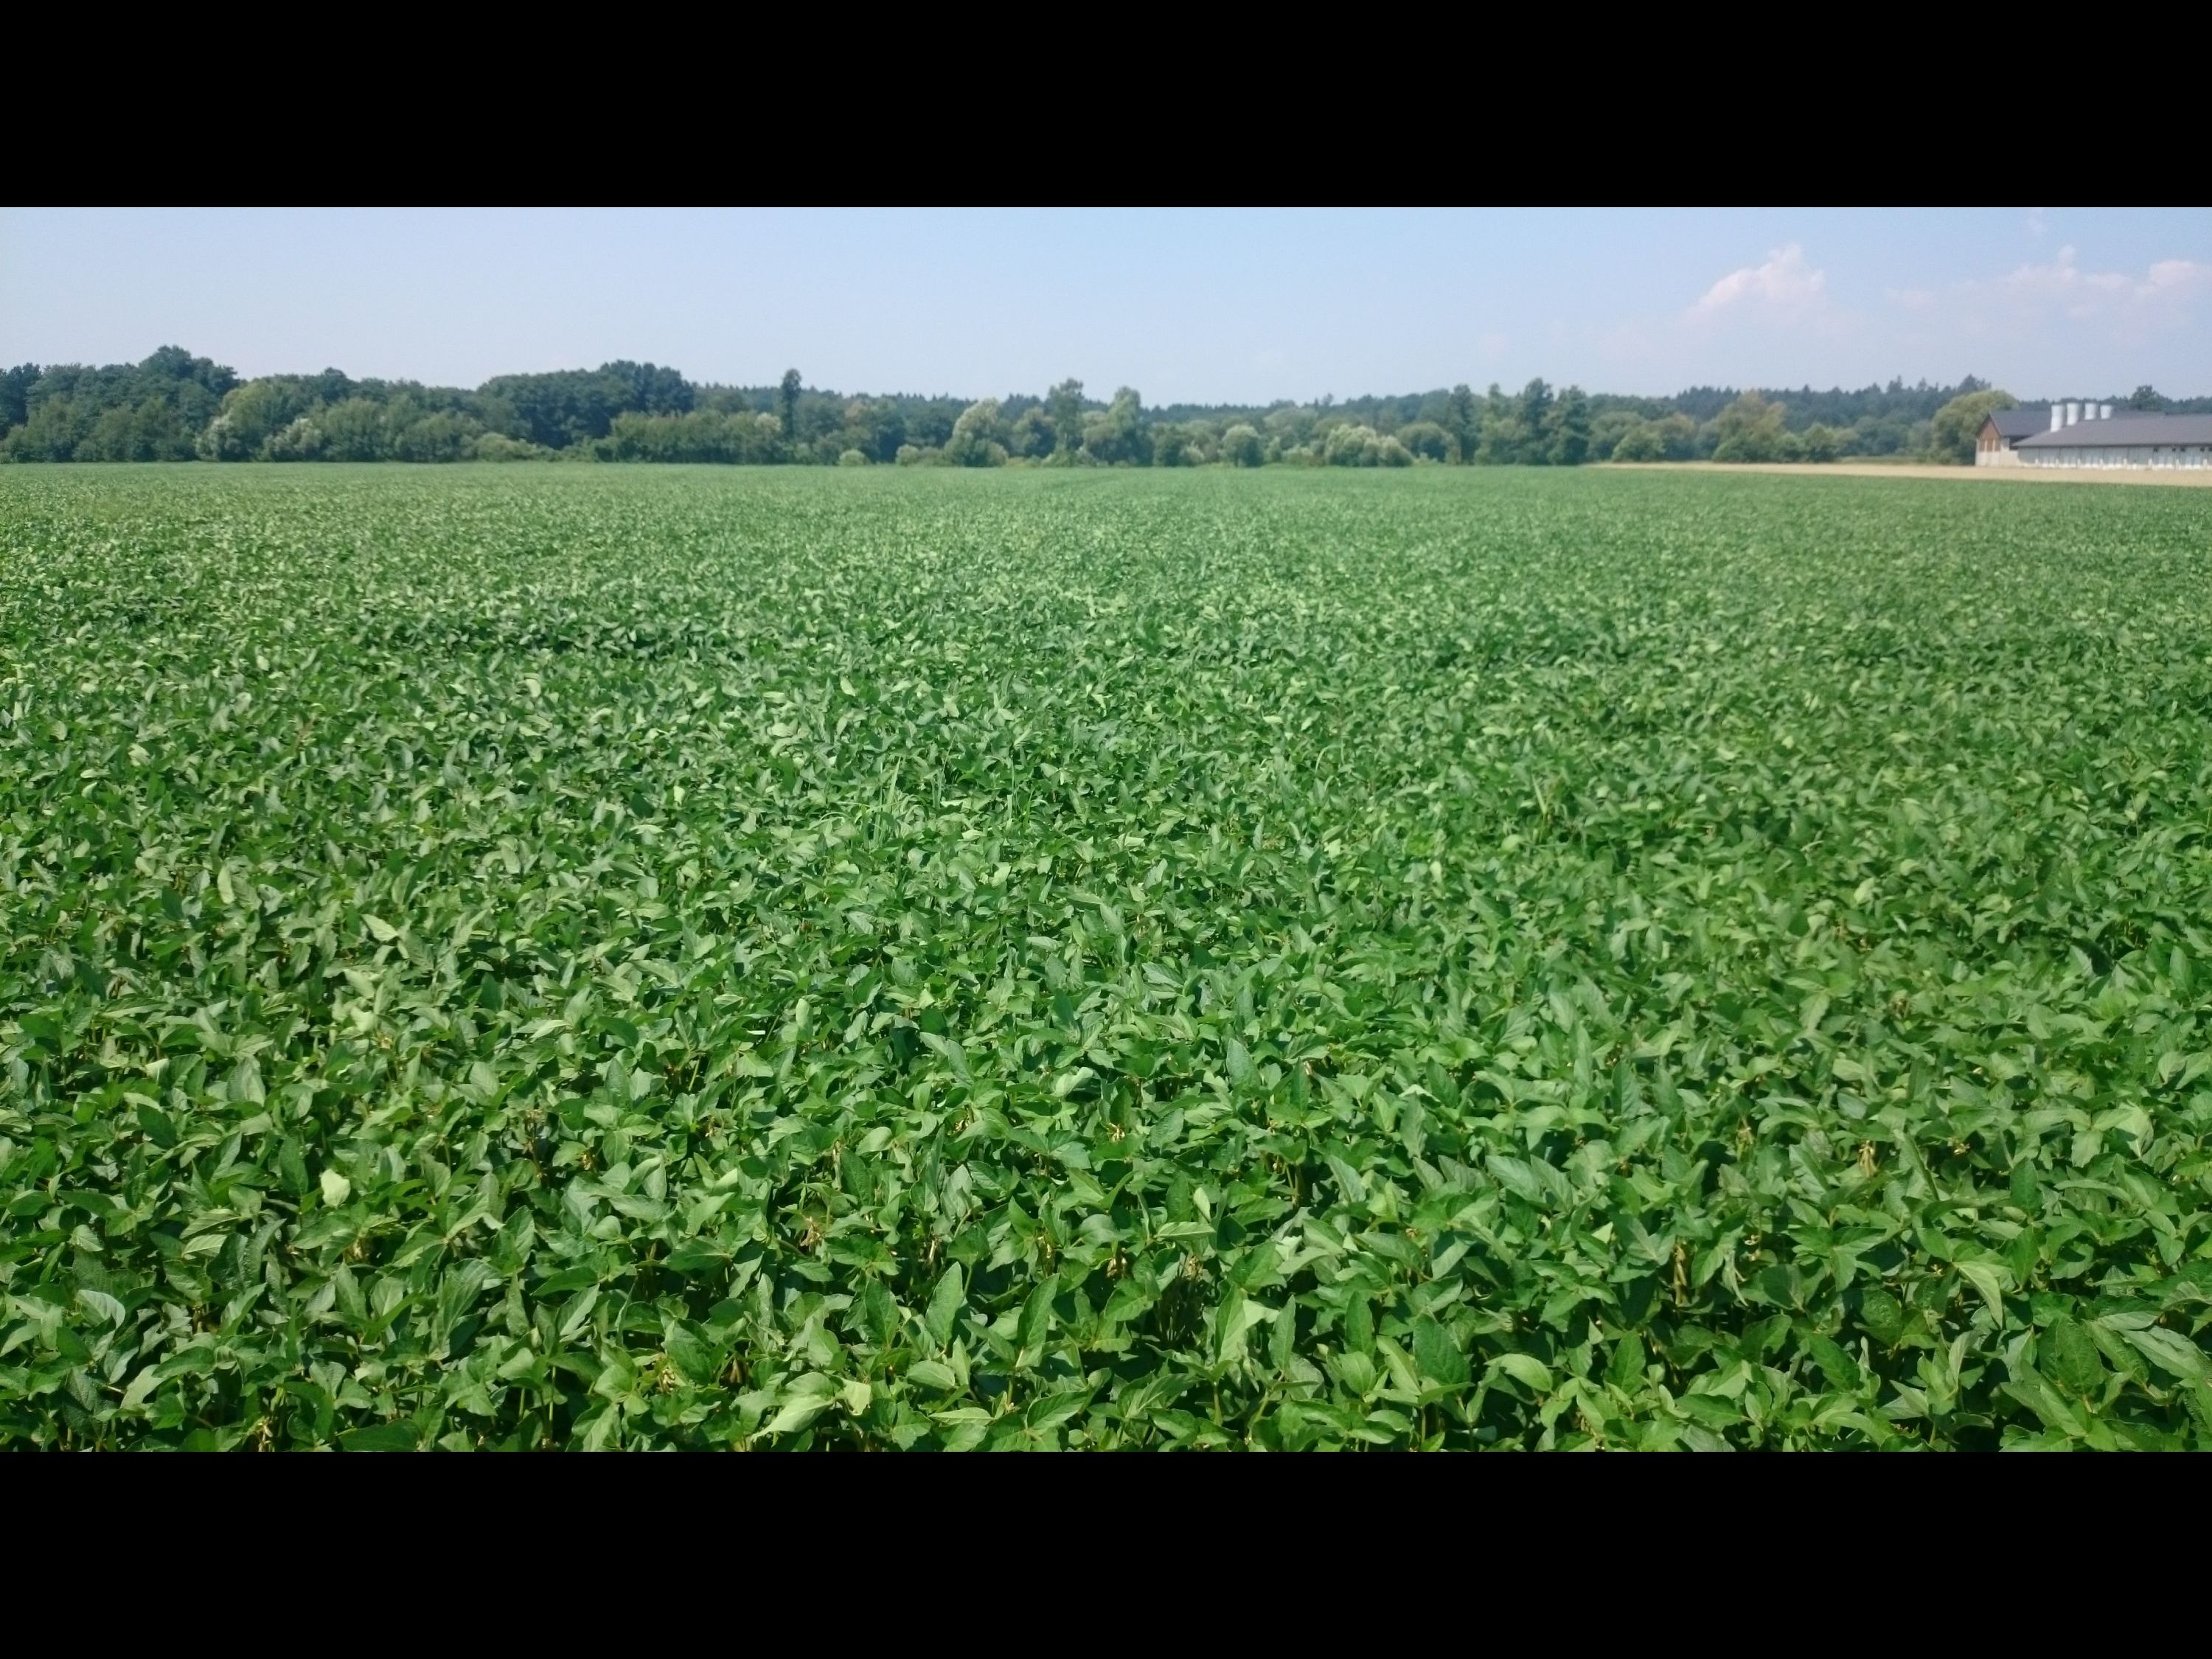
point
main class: Cropland
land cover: Soya
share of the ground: > 75 %
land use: Agriculture (excluding fallow land and kitchen gardens)
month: July
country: AT
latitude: 47.0979
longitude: 16.1016
